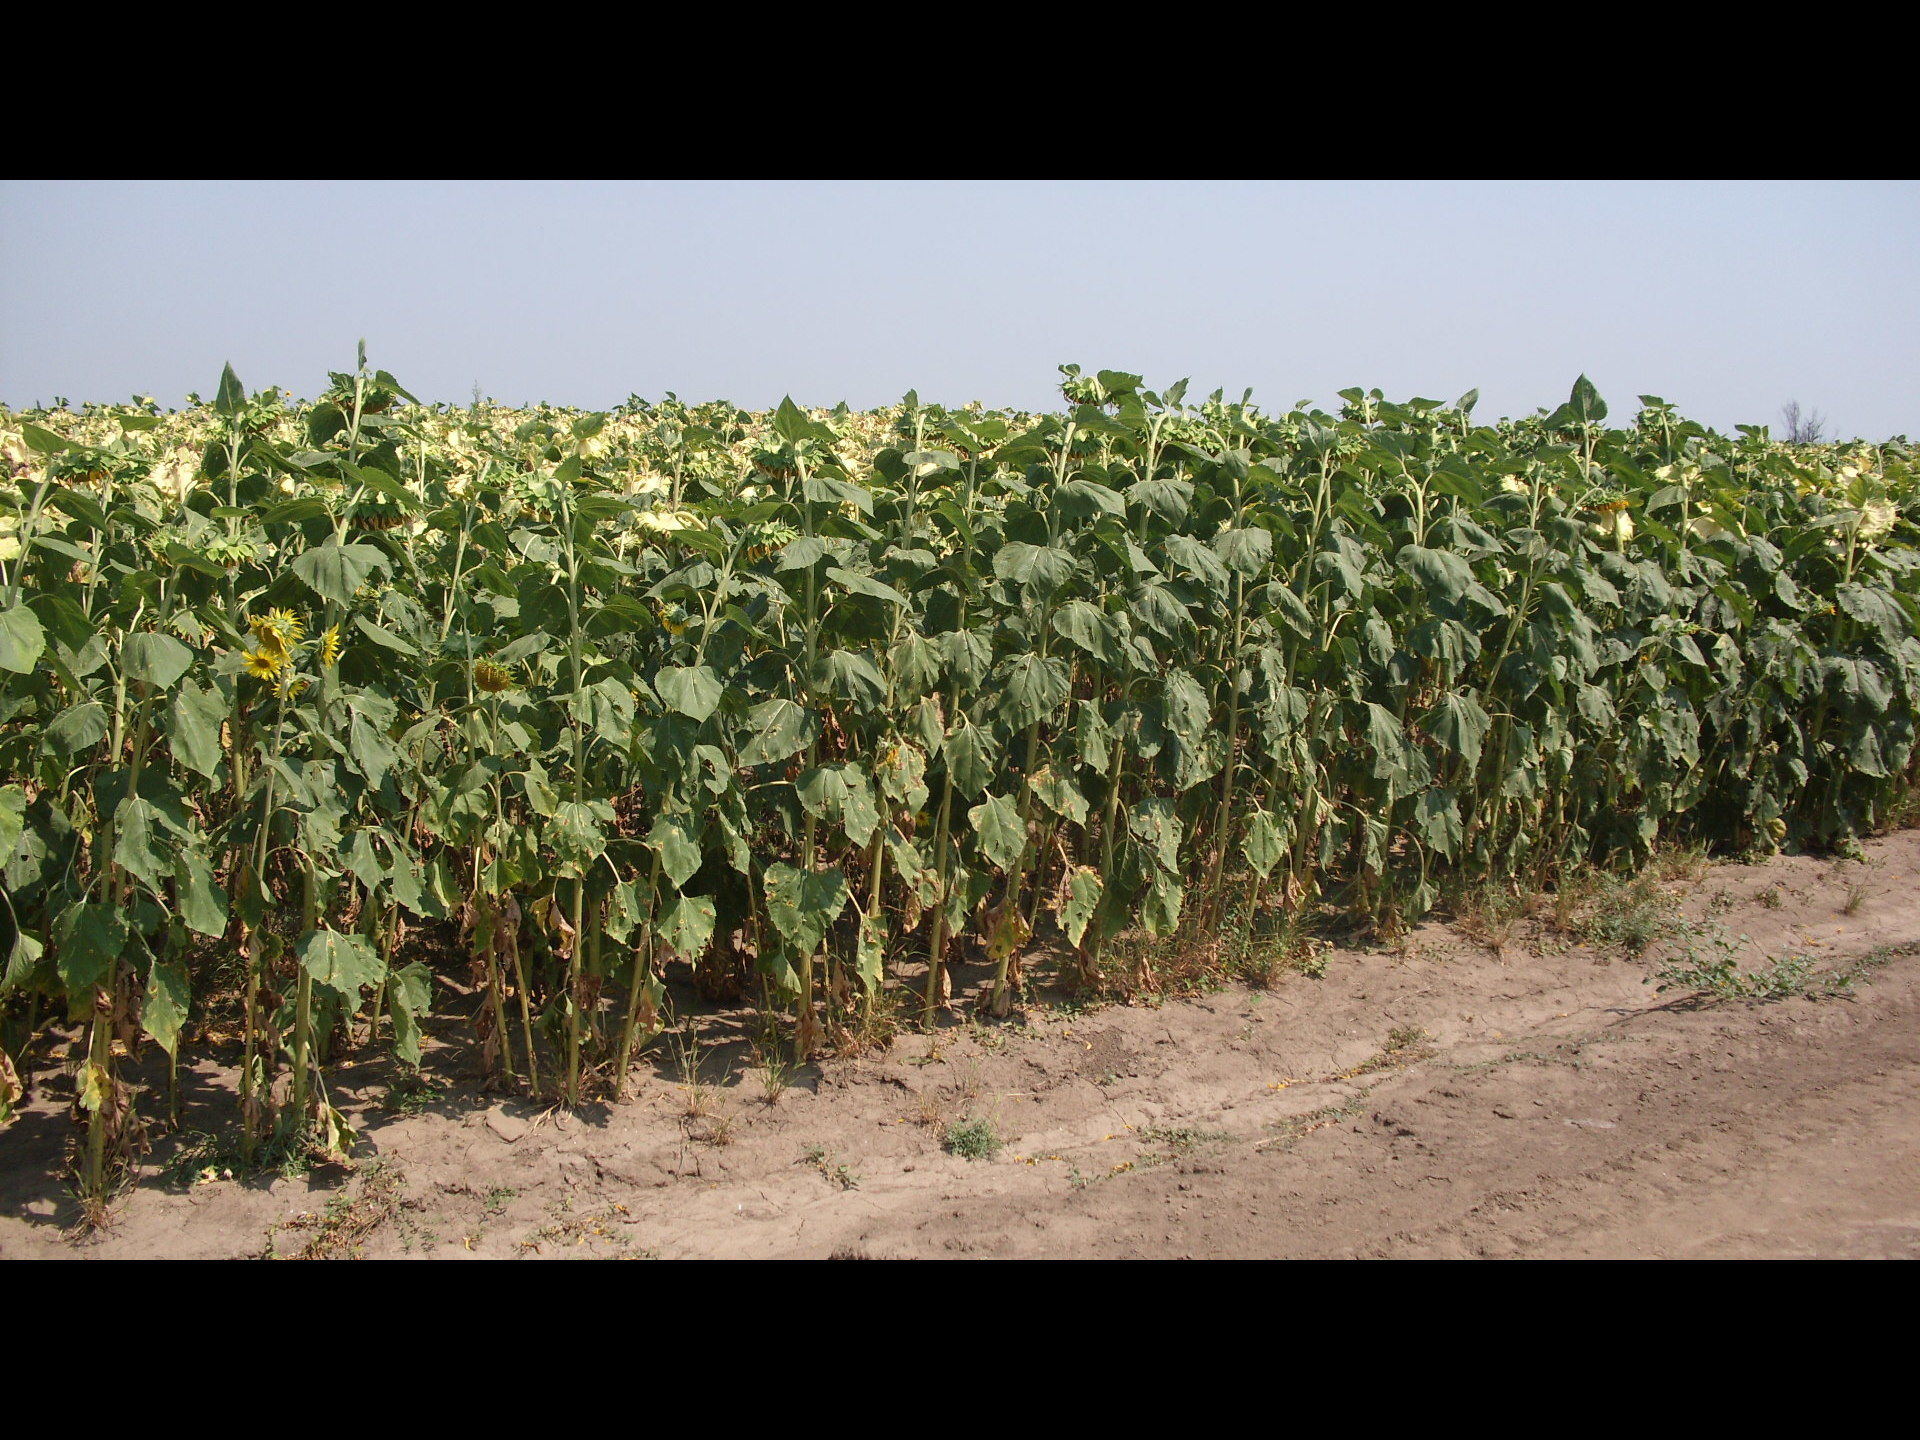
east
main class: Cropland
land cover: Maize
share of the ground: > 75 %
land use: Agriculture (excluding fallow land and kitchen gardens)
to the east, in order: Maize; Grass margins; Tracks; Sunflower
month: July
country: BG
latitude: 43.7901
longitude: 23.3797
